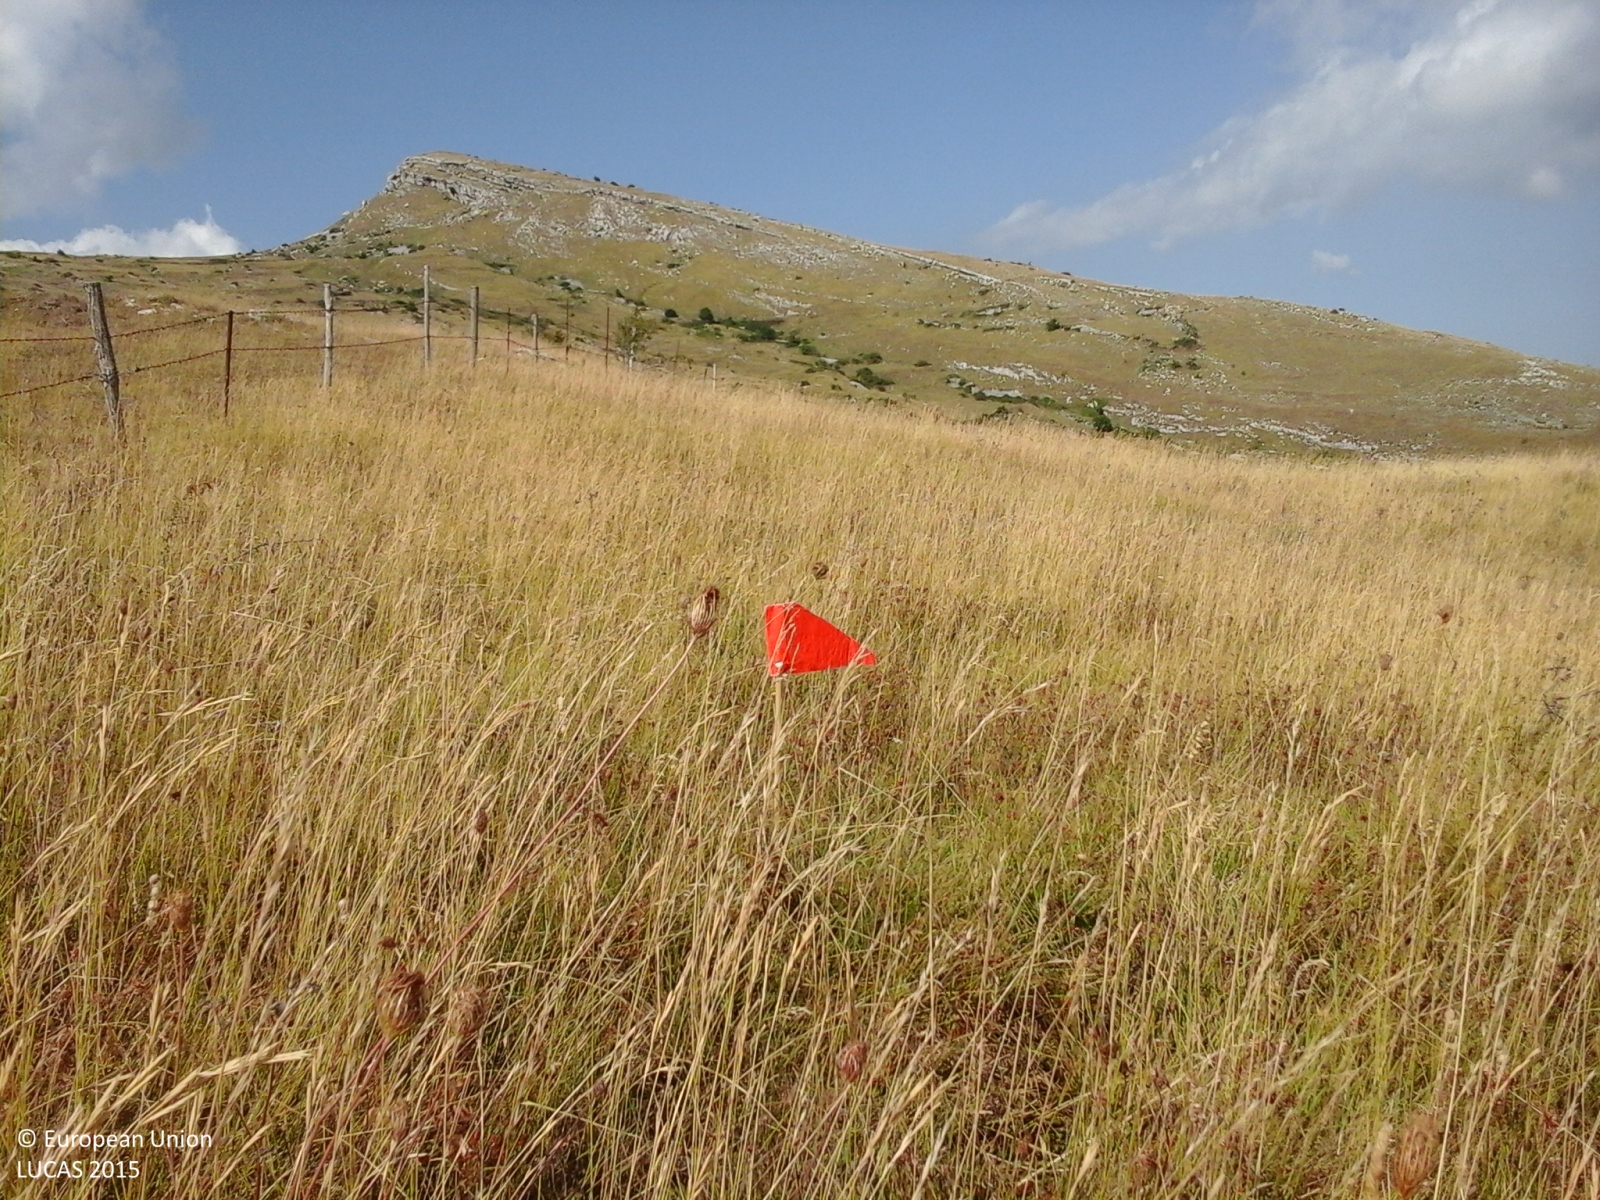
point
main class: Grassland
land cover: Grassland without tree/shrub cover
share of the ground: > 75 %
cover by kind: herbaceous plants 100 %
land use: Agriculture (excluding fallow land and kitchen gardens)
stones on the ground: 25 - 50 %
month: August
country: IT
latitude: 41.8388
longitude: 14.3087
